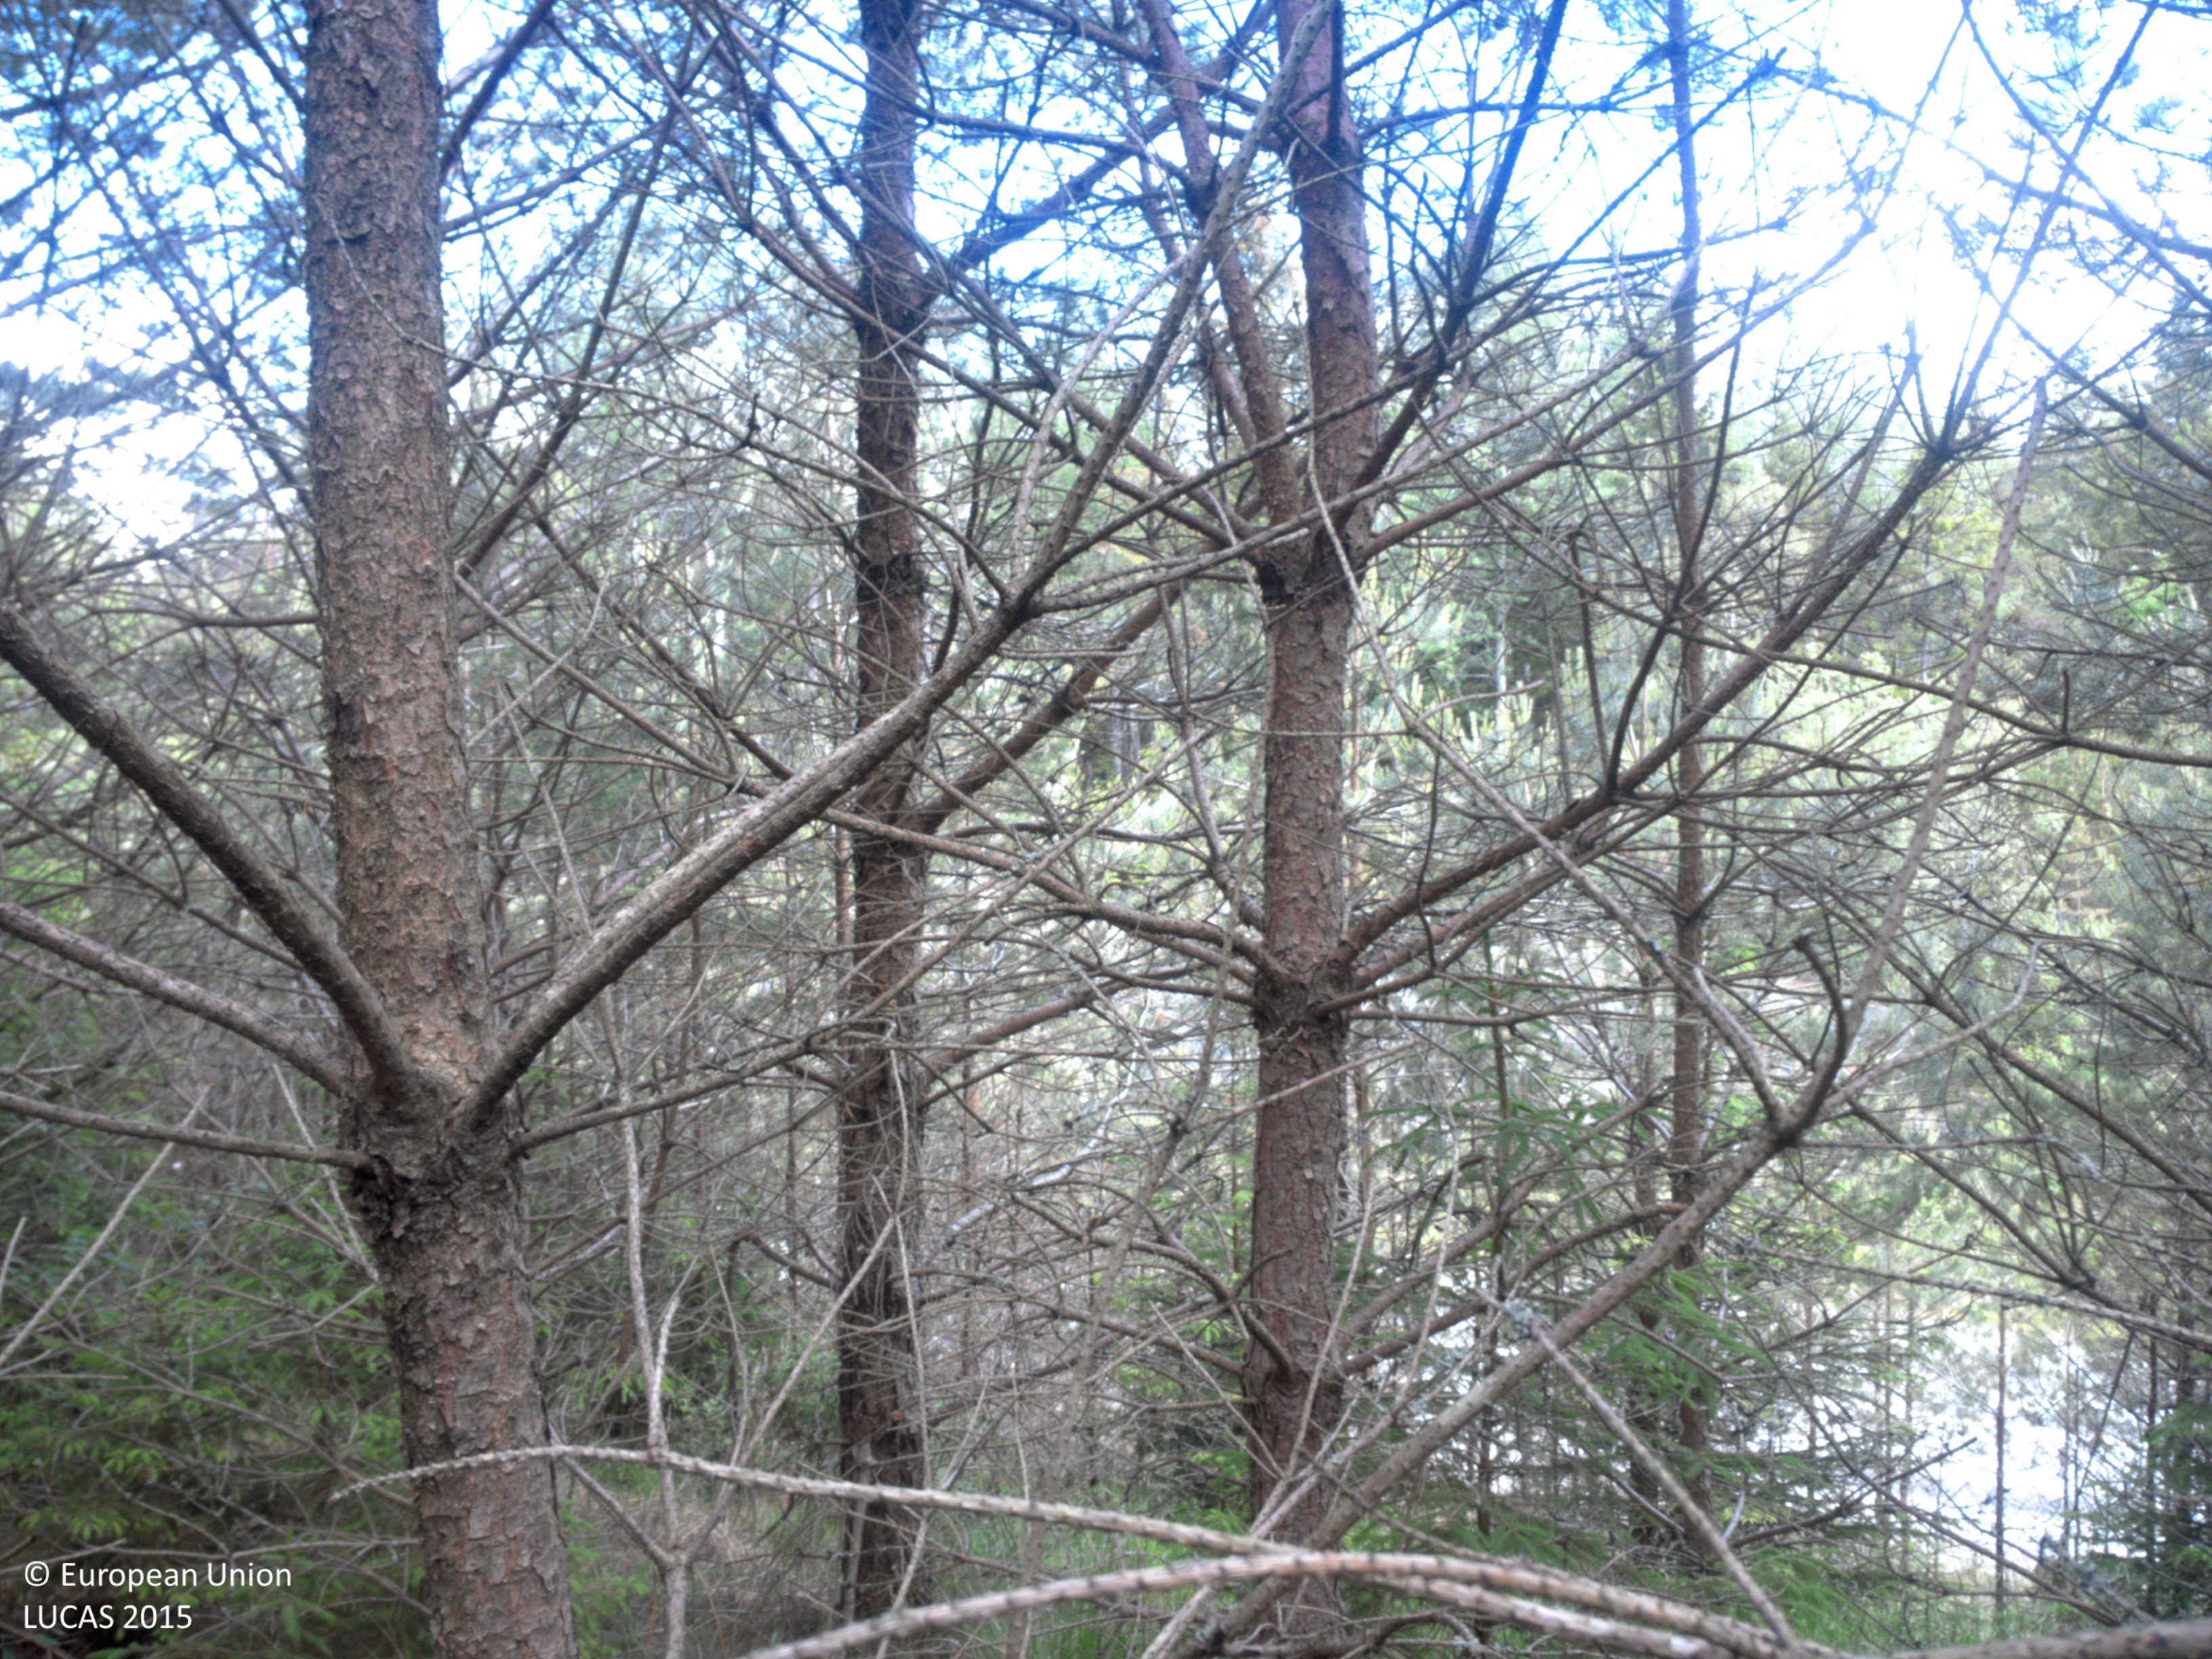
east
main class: Woodland
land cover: Pine dominated coniferous woodland
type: boreal forest
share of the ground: > 75 %
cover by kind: coniferous forest trees 80 %, herbaceous plants 10 %, lichens and mosses 10 %
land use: Forestry
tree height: < 5 m
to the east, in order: Pine dominated coniferous woodland; Grassland without tree/shrub cover; Paved roads, cycling and walking lanes; Grass margins; Rocks and stones; Pine dominated coniferous woodland; Pine dominated mixed woodland; Spruce dominated coniferous woodland; Spruce dominated mixed woodland; Spruce dominated coniferous woodland
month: June
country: SE
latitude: 58.8216
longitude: 11.6069
